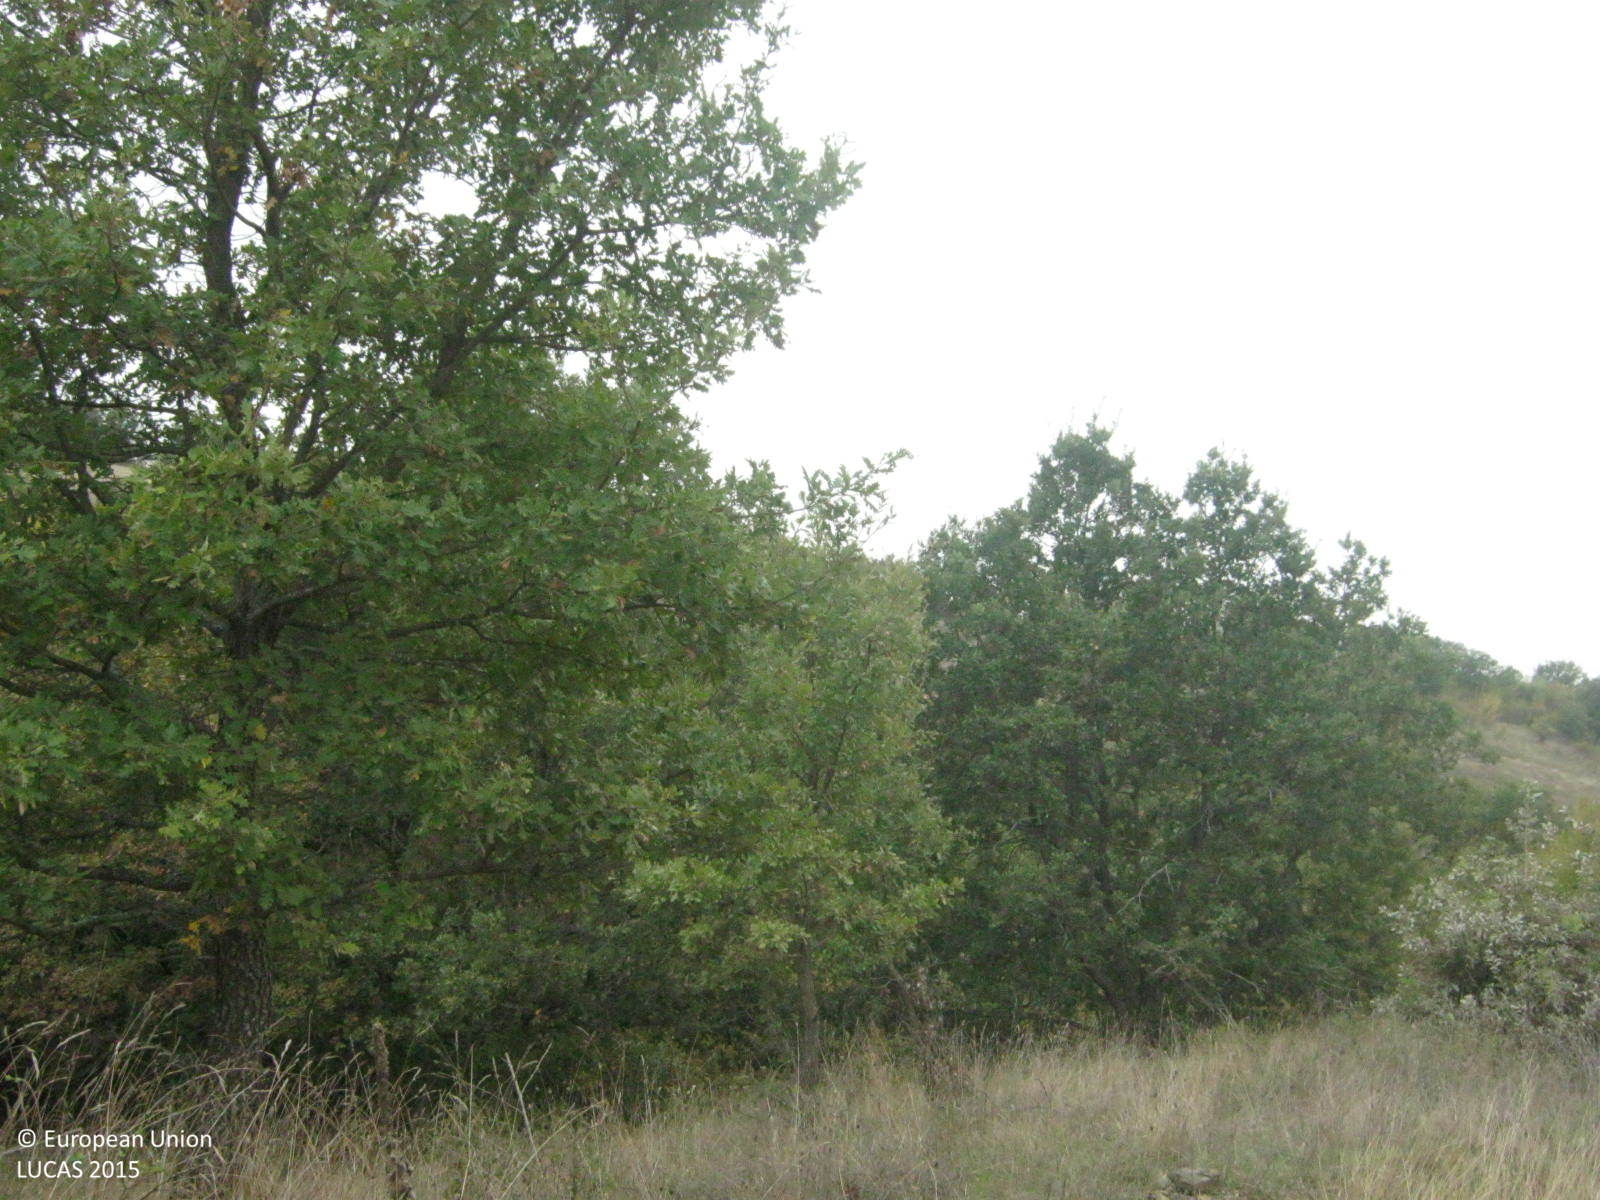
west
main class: Woodland
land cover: Broadleaved woodland
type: thermophilous deciduous forest
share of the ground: > 75 %
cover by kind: broadleaved forest trees 75 %, unconsolidated bare surface 20 %, shrubs 5 %
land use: Forestry
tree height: > 5 m
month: October
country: GR
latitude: 41.0009
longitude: 23.0545
